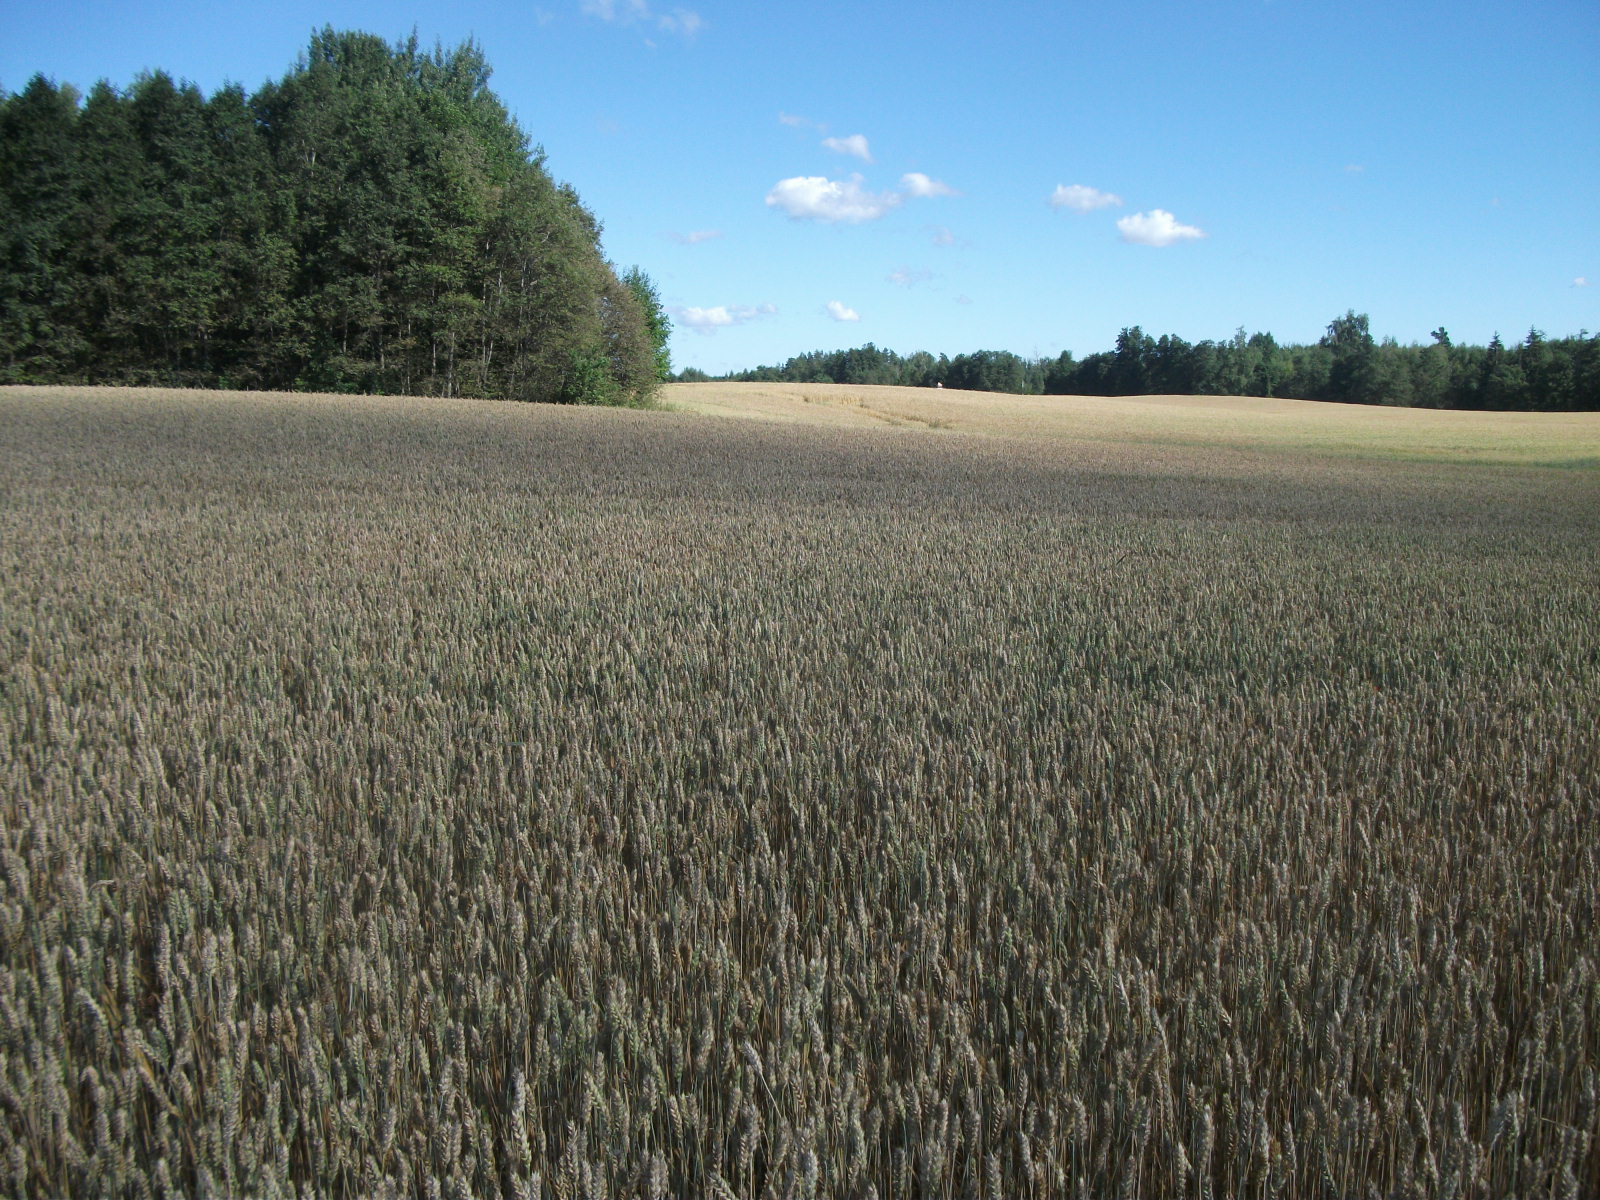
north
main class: Cropland
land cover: Common wheat
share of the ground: > 75 %
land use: Agriculture (excluding fallow land and kitchen gardens)
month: August
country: LV
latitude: 56.6994
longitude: 26.2924
